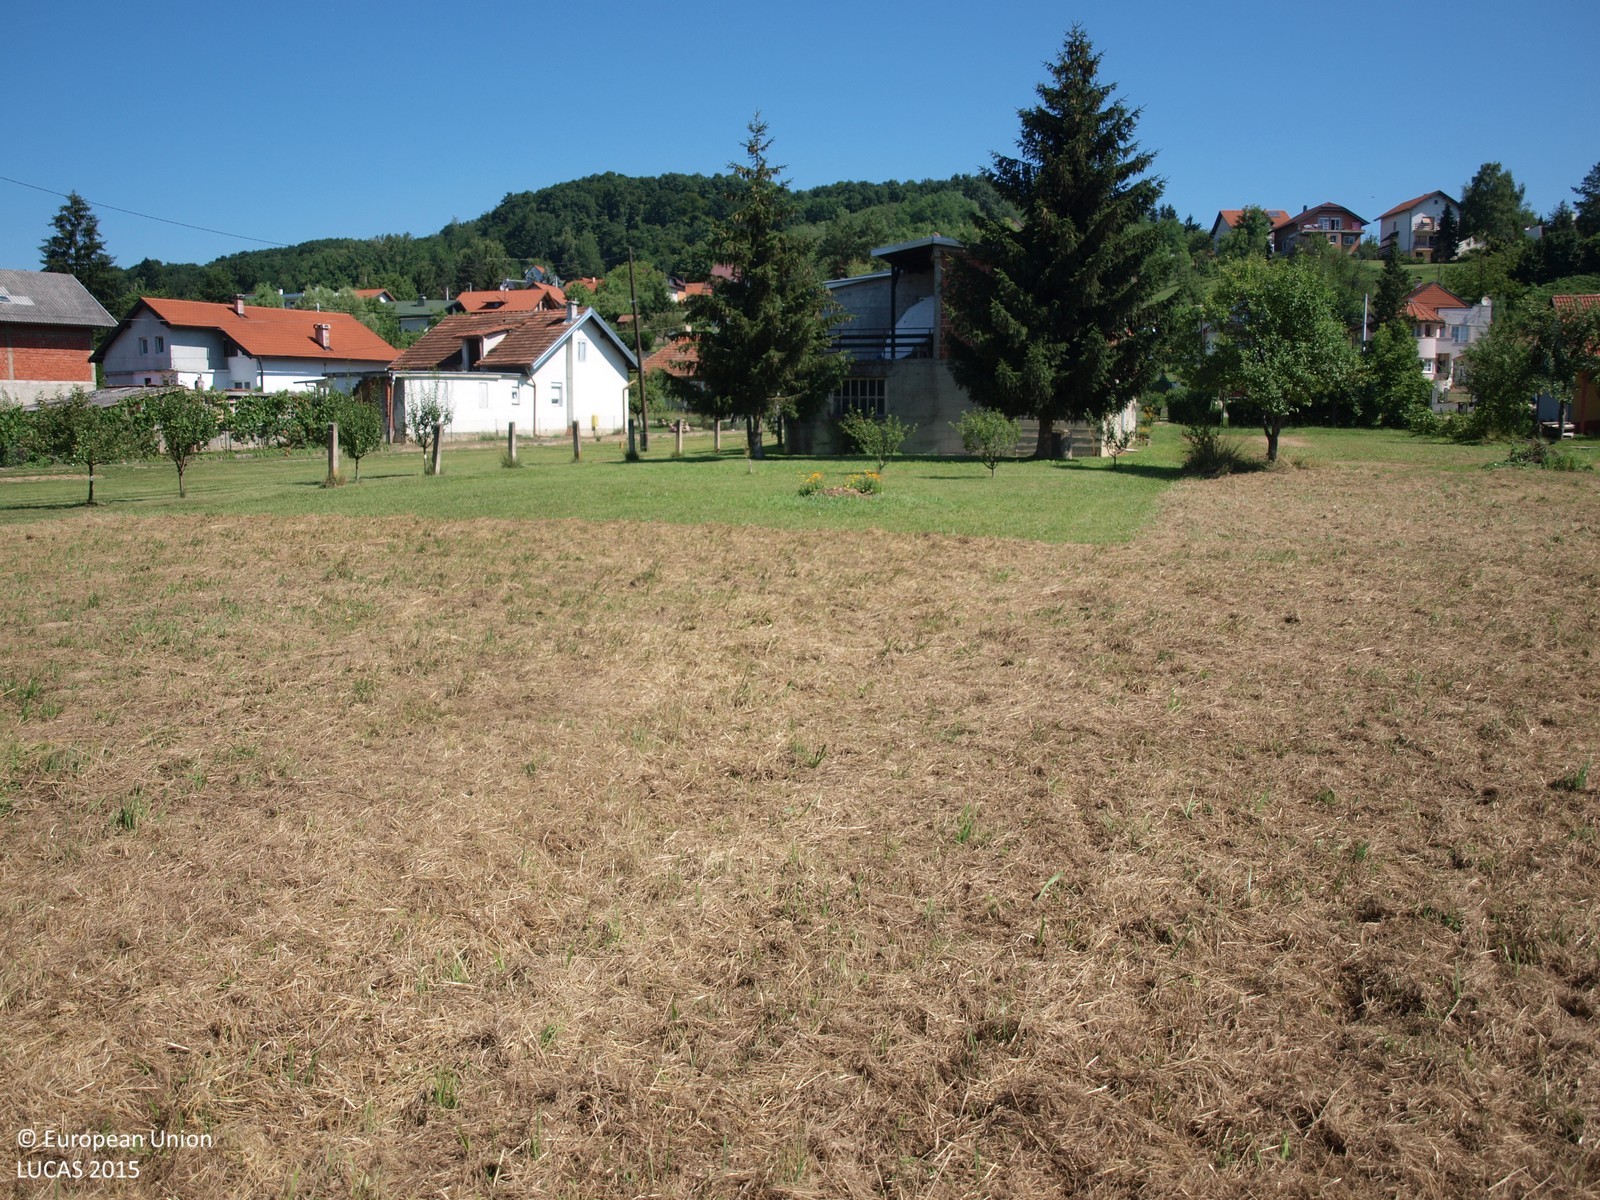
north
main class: Grassland
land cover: Grassland without tree/shrub cover
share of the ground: > 75 %
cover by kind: herbaceous plants 100 %
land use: Agriculture (excluding fallow land and kitchen gardens)
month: July
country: HR
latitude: 45.8712
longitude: 15.7561
